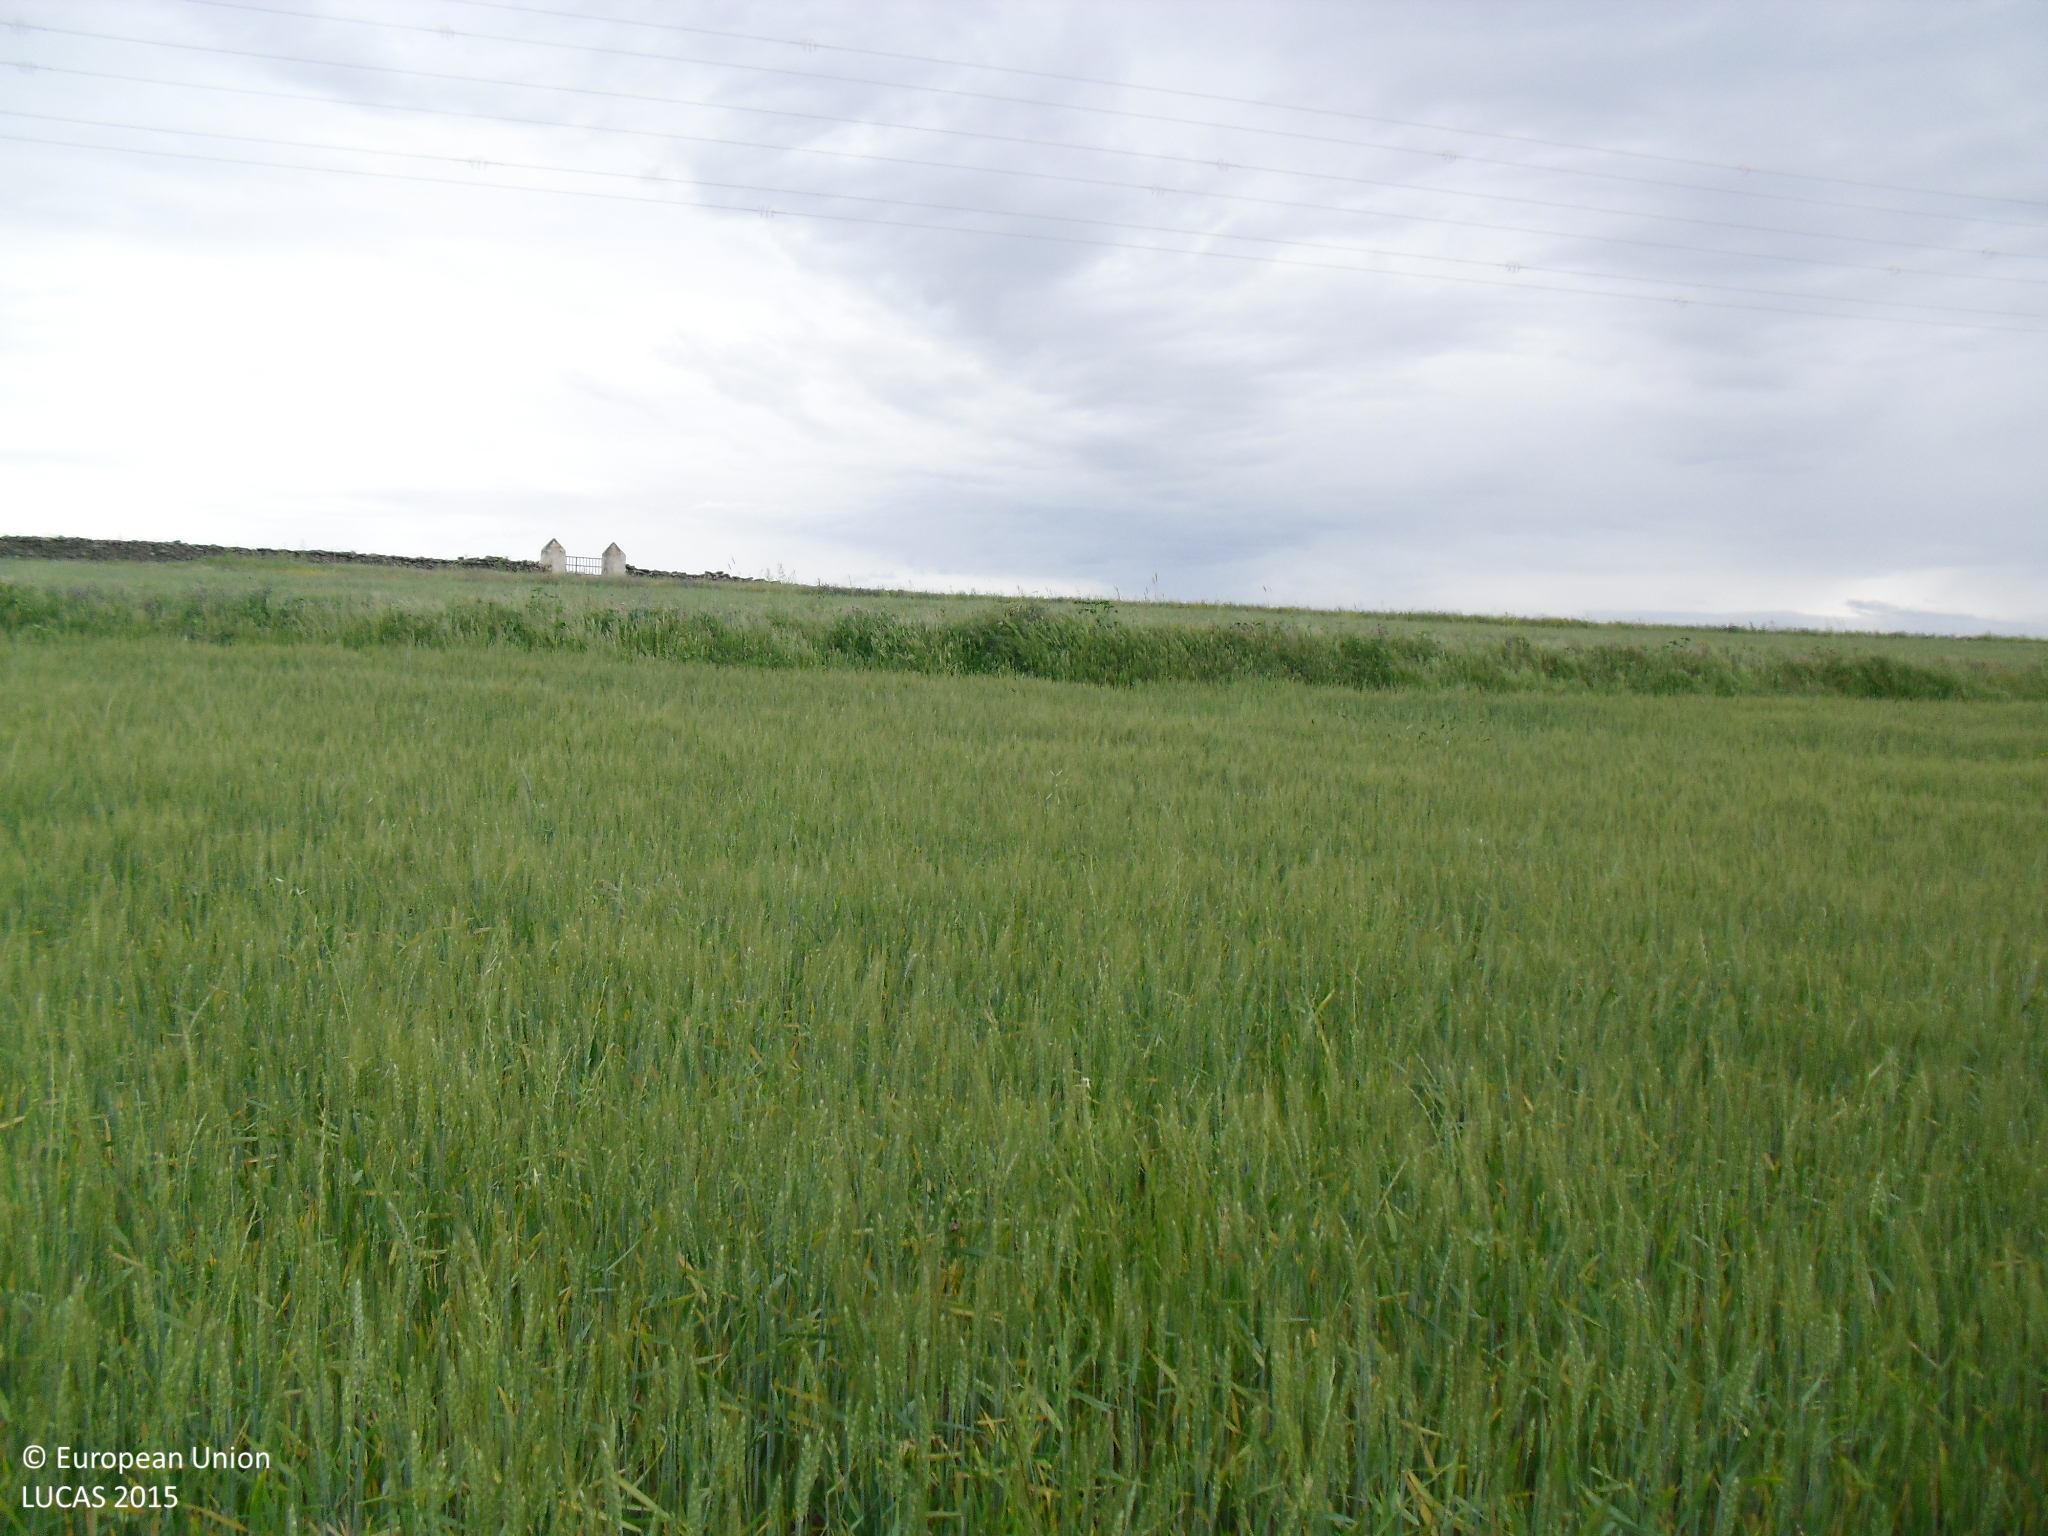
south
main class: Cropland
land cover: Common wheat
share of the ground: > 75 %
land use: Agriculture (excluding fallow land and kitchen gardens)
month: April
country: ES
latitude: 39.4703
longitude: -6.5901
